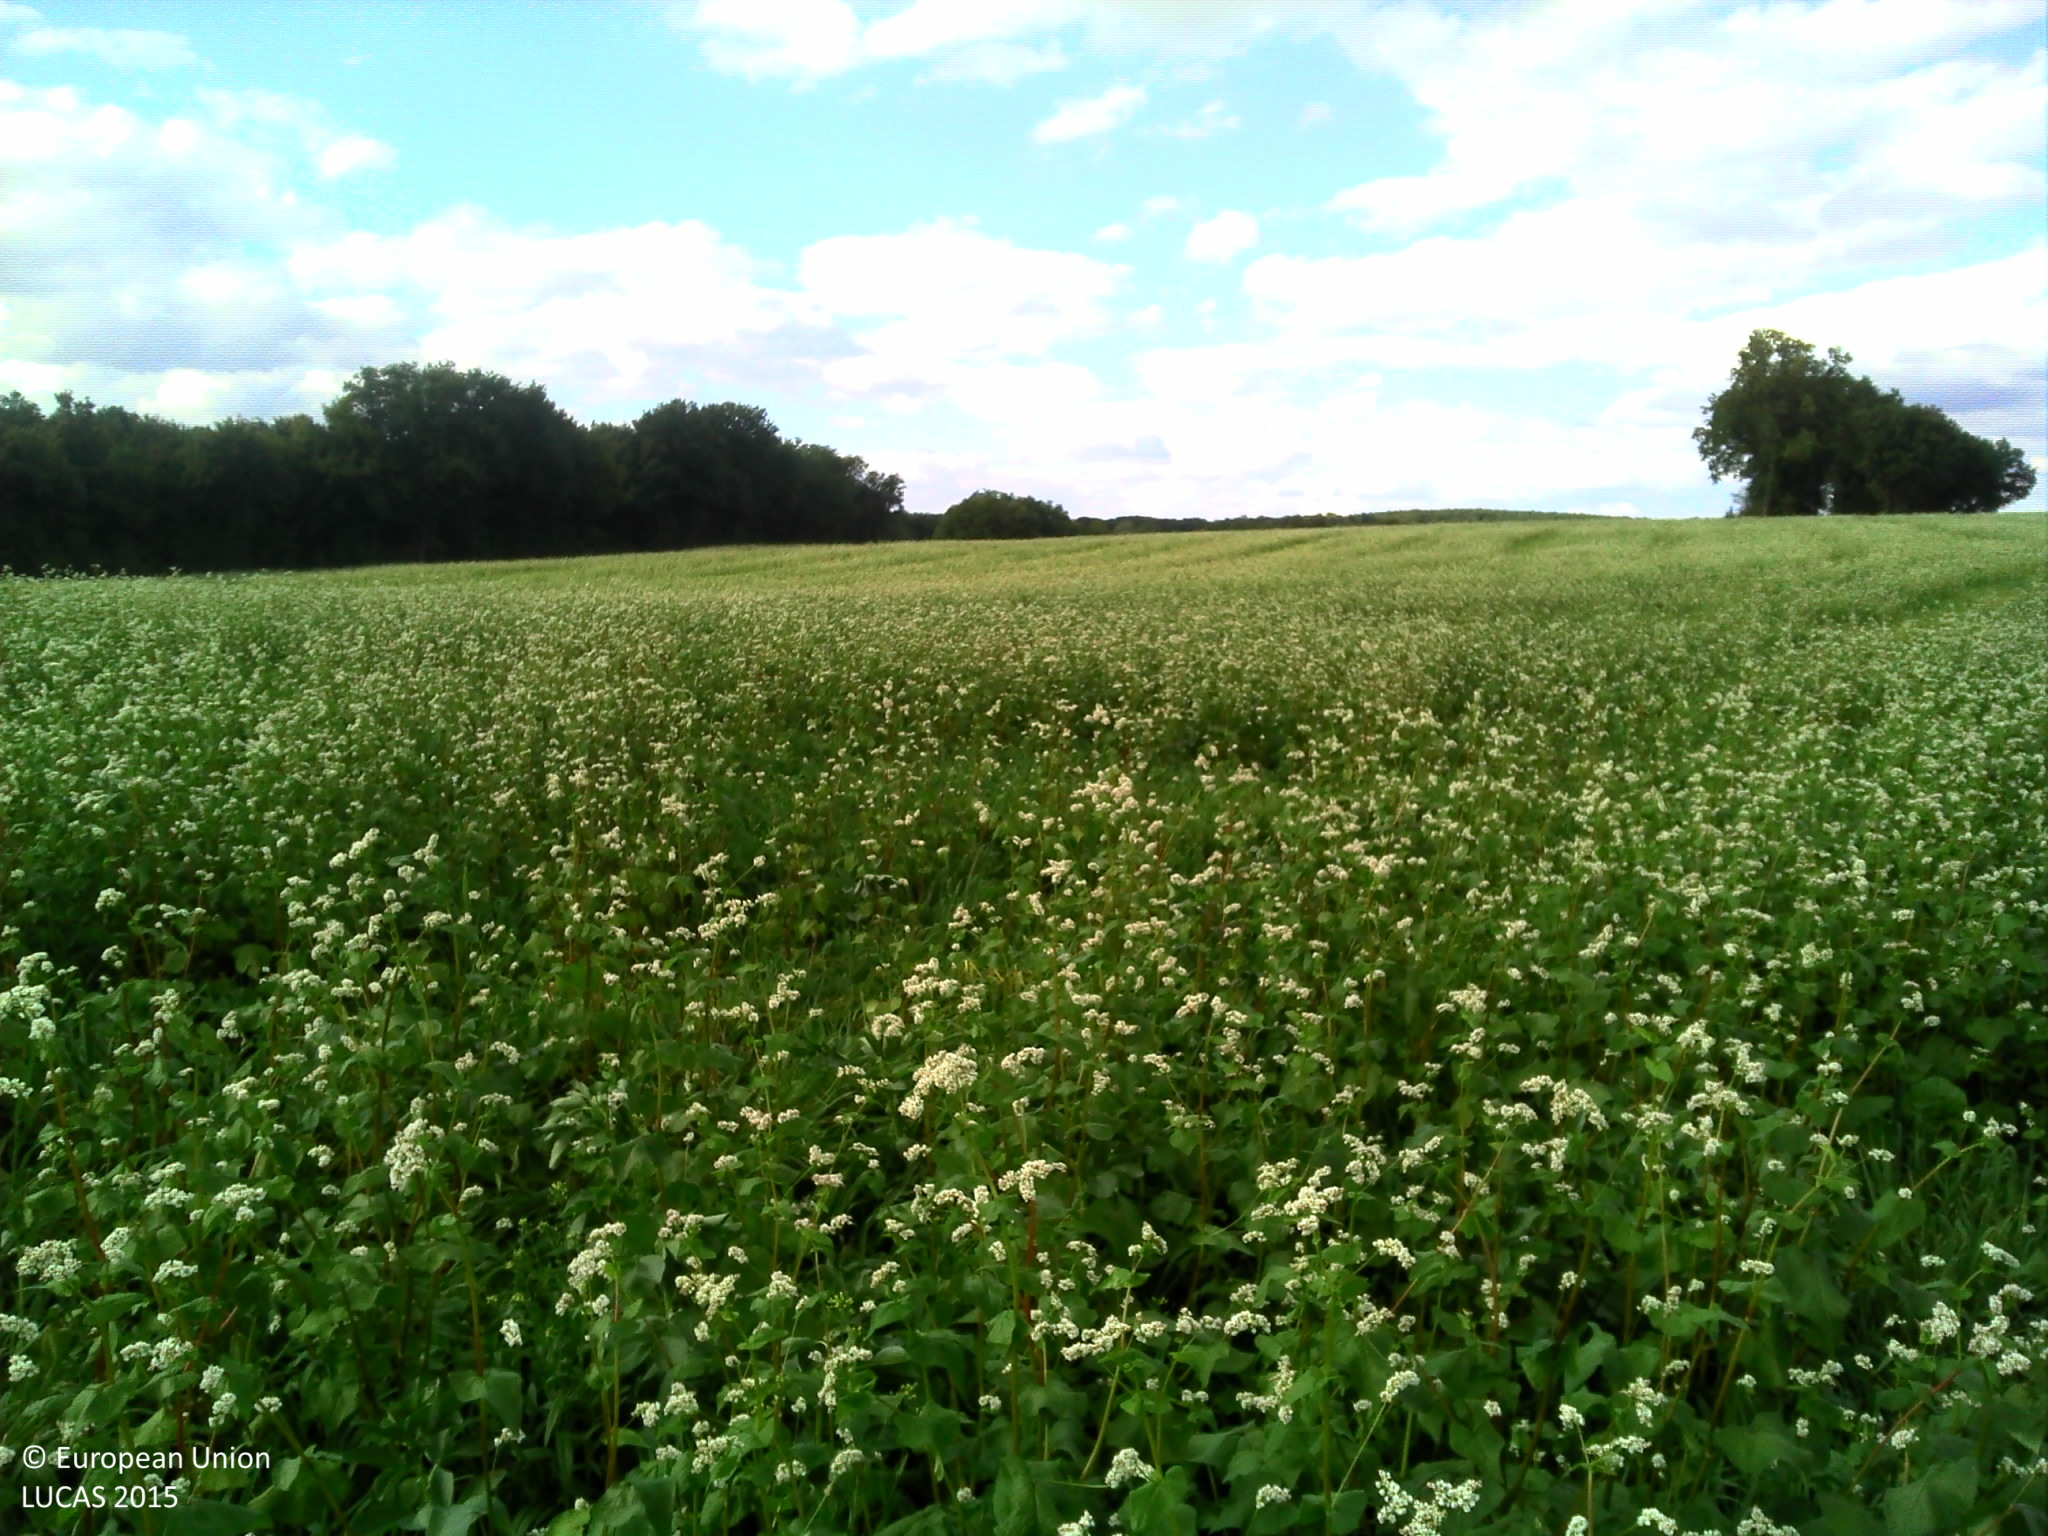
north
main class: Cropland
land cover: Other cereals
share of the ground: > 75 %
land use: Agriculture (excluding fallow land and kitchen gardens)
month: September
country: FR
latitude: 47.4067
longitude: 6.3574
